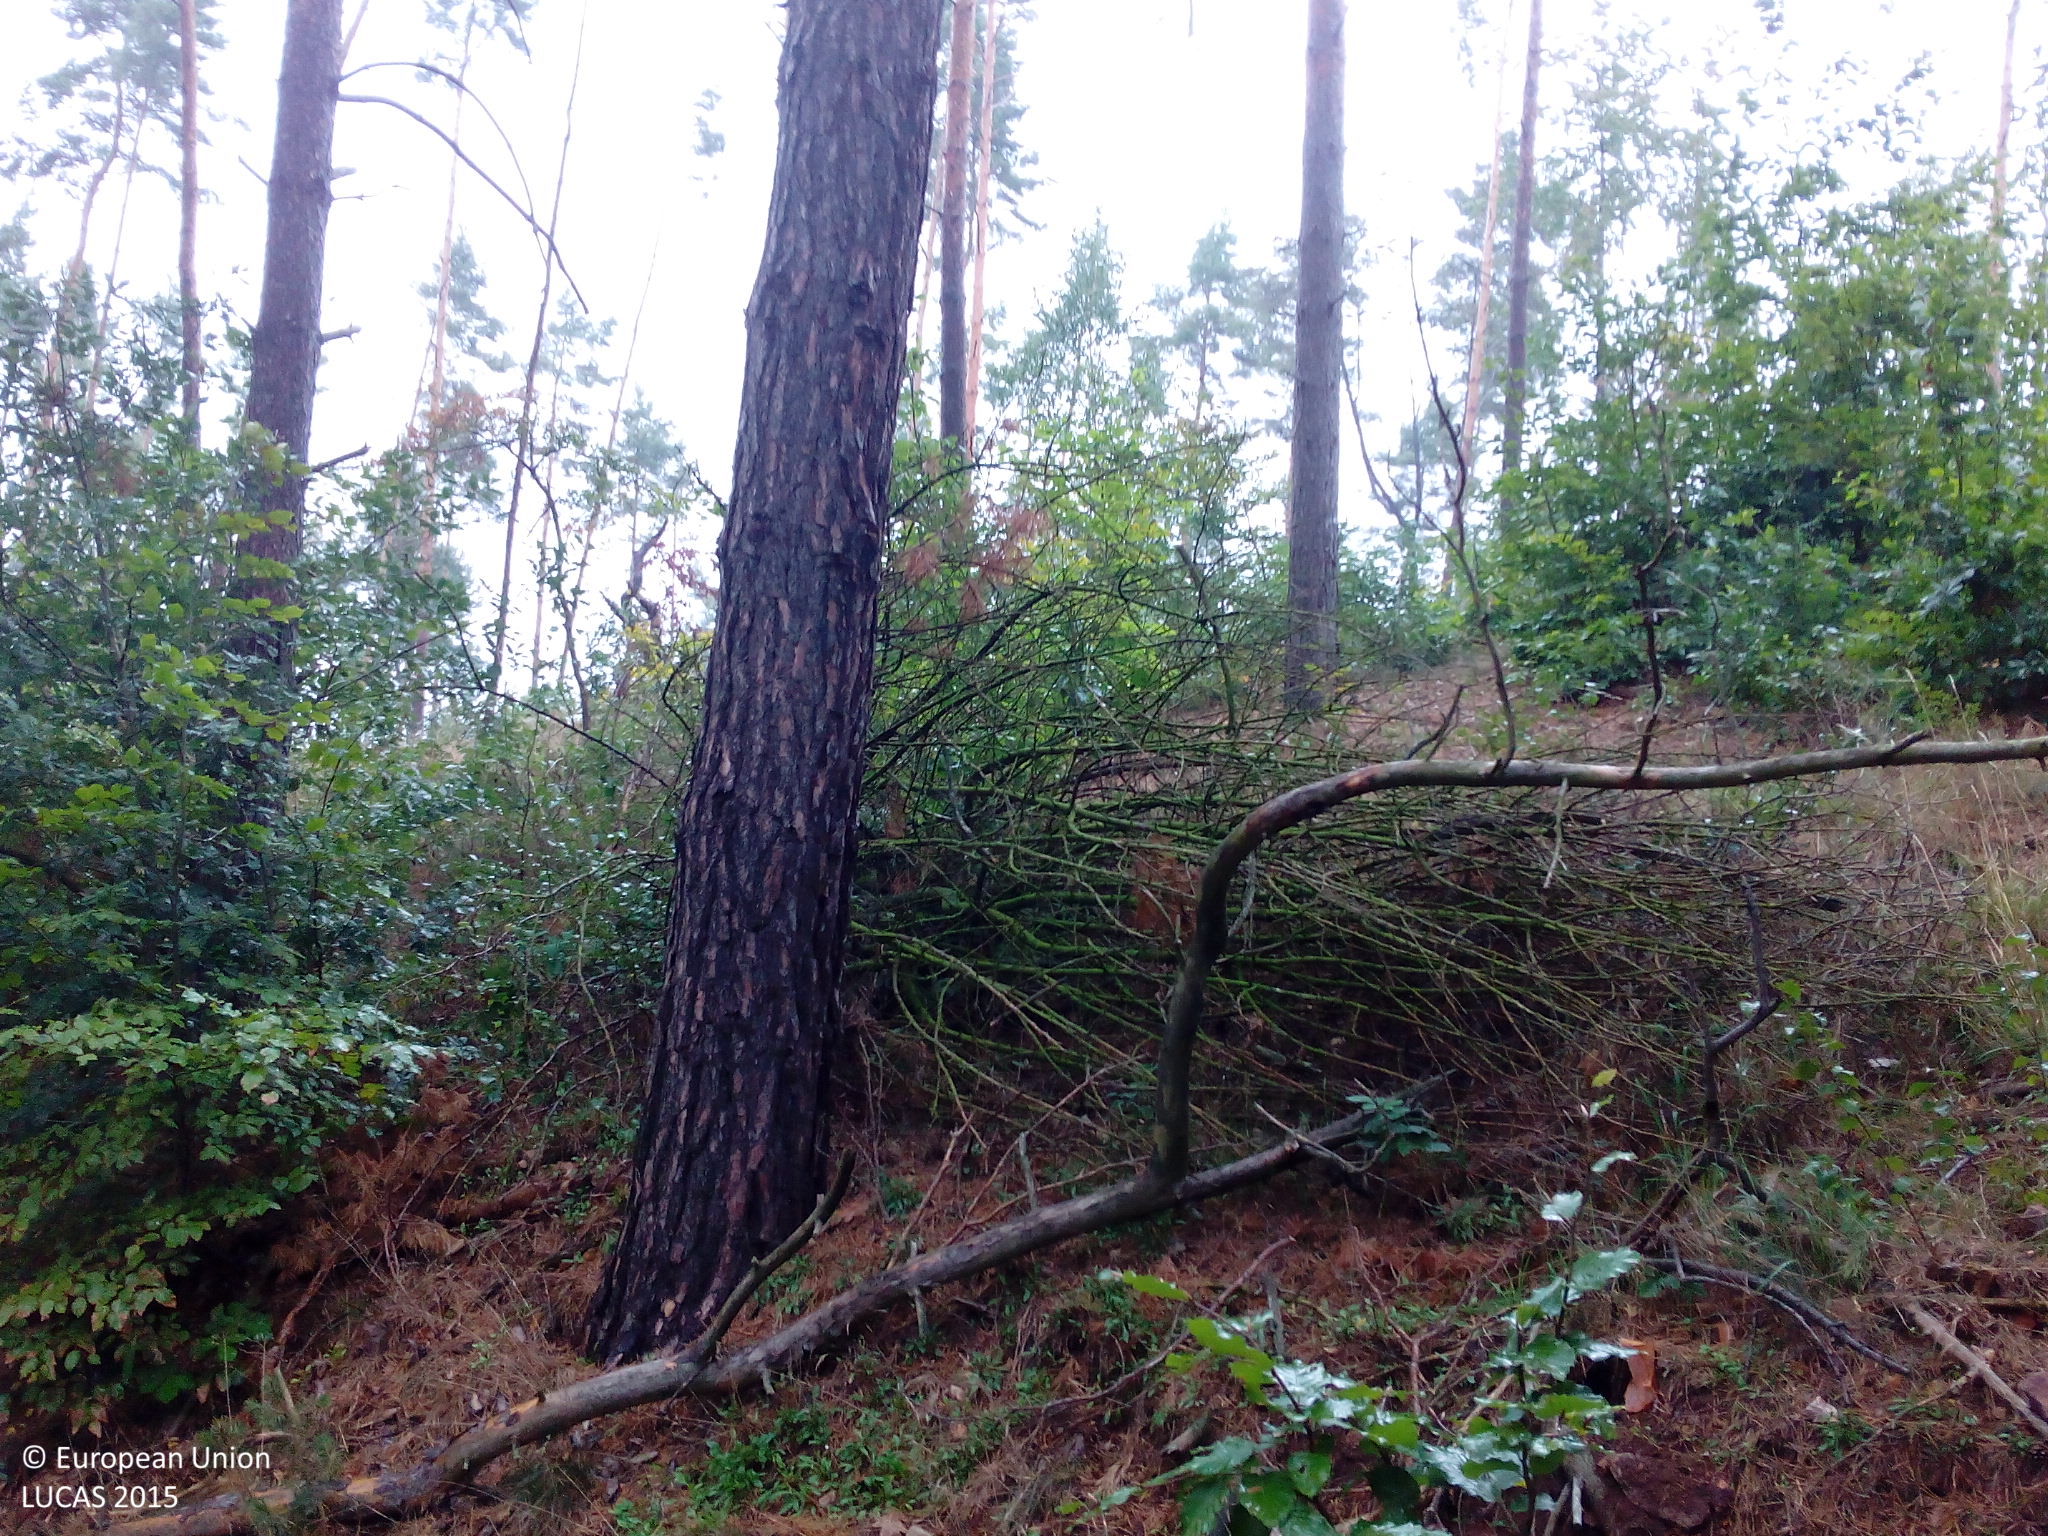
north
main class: Woodland
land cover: Pine dominated mixed woodland
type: hemiboreal forest and nemoral coniferous forest and mixed broadleaved-coniferous forest
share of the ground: > 75 %
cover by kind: coniferous forest trees 75 %, broadleaved forest trees 25 %
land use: Forestry
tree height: > 5 m
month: September
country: DE
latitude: 51.4203
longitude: 11.0207
